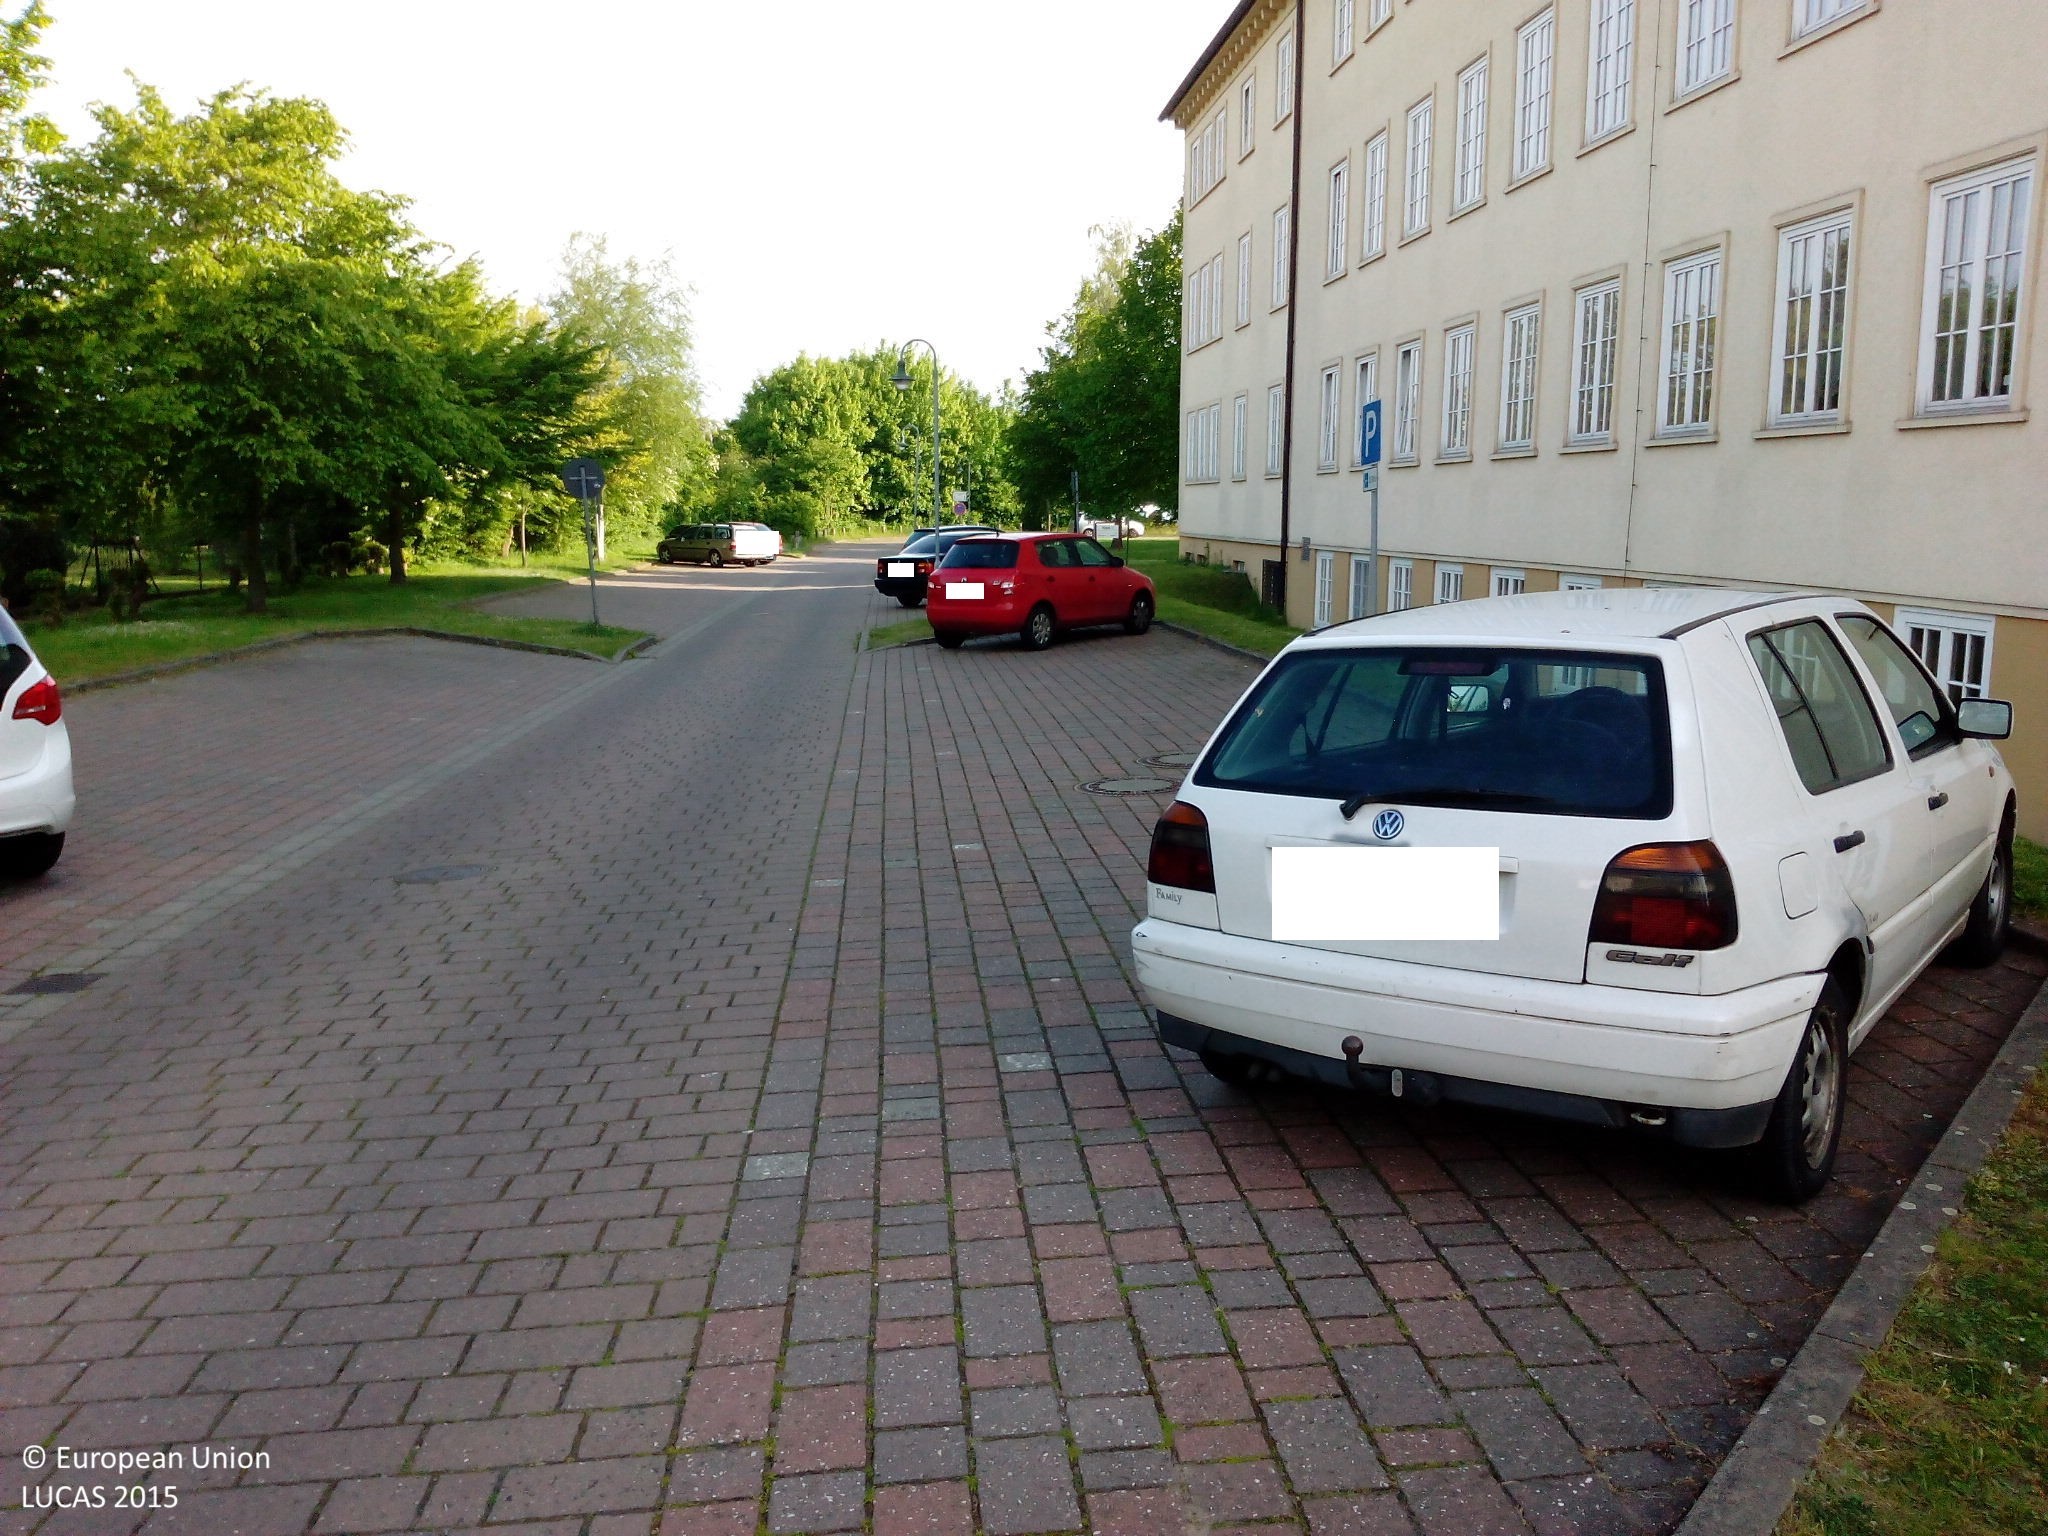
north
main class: Grassland
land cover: Grassland with sparse tree/shrub cover
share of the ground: > 75 %
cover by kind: herbaceous plants 80 %, coniferous forest trees 5 %, lichens and mosses 5 %, unconsolidated bare surface 5 %
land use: Community services
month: May
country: DE
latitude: 52.8573
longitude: 11.1431
